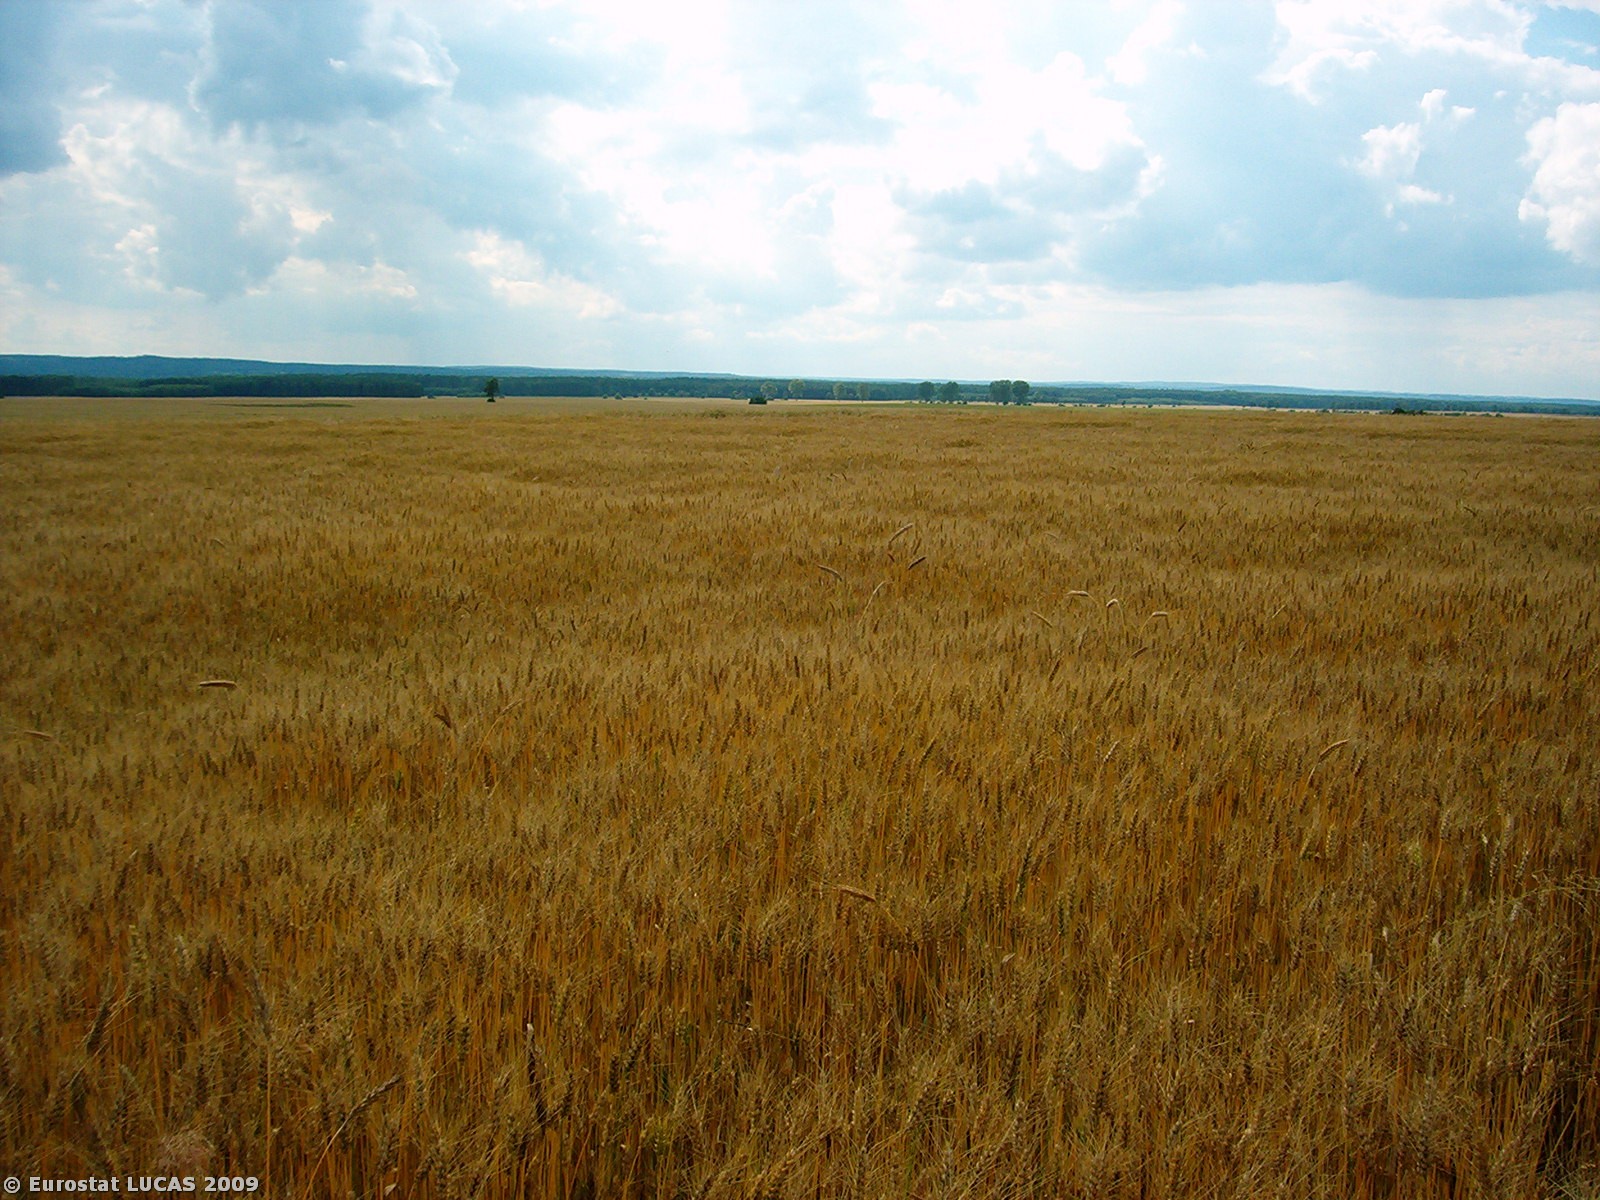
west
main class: Cropland
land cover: Common wheat
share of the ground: > 75 %
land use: Agriculture (excluding fallow land and kitchen gardens)
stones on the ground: < 10 %
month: July
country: PL
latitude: 52.3301
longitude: 15.7129
